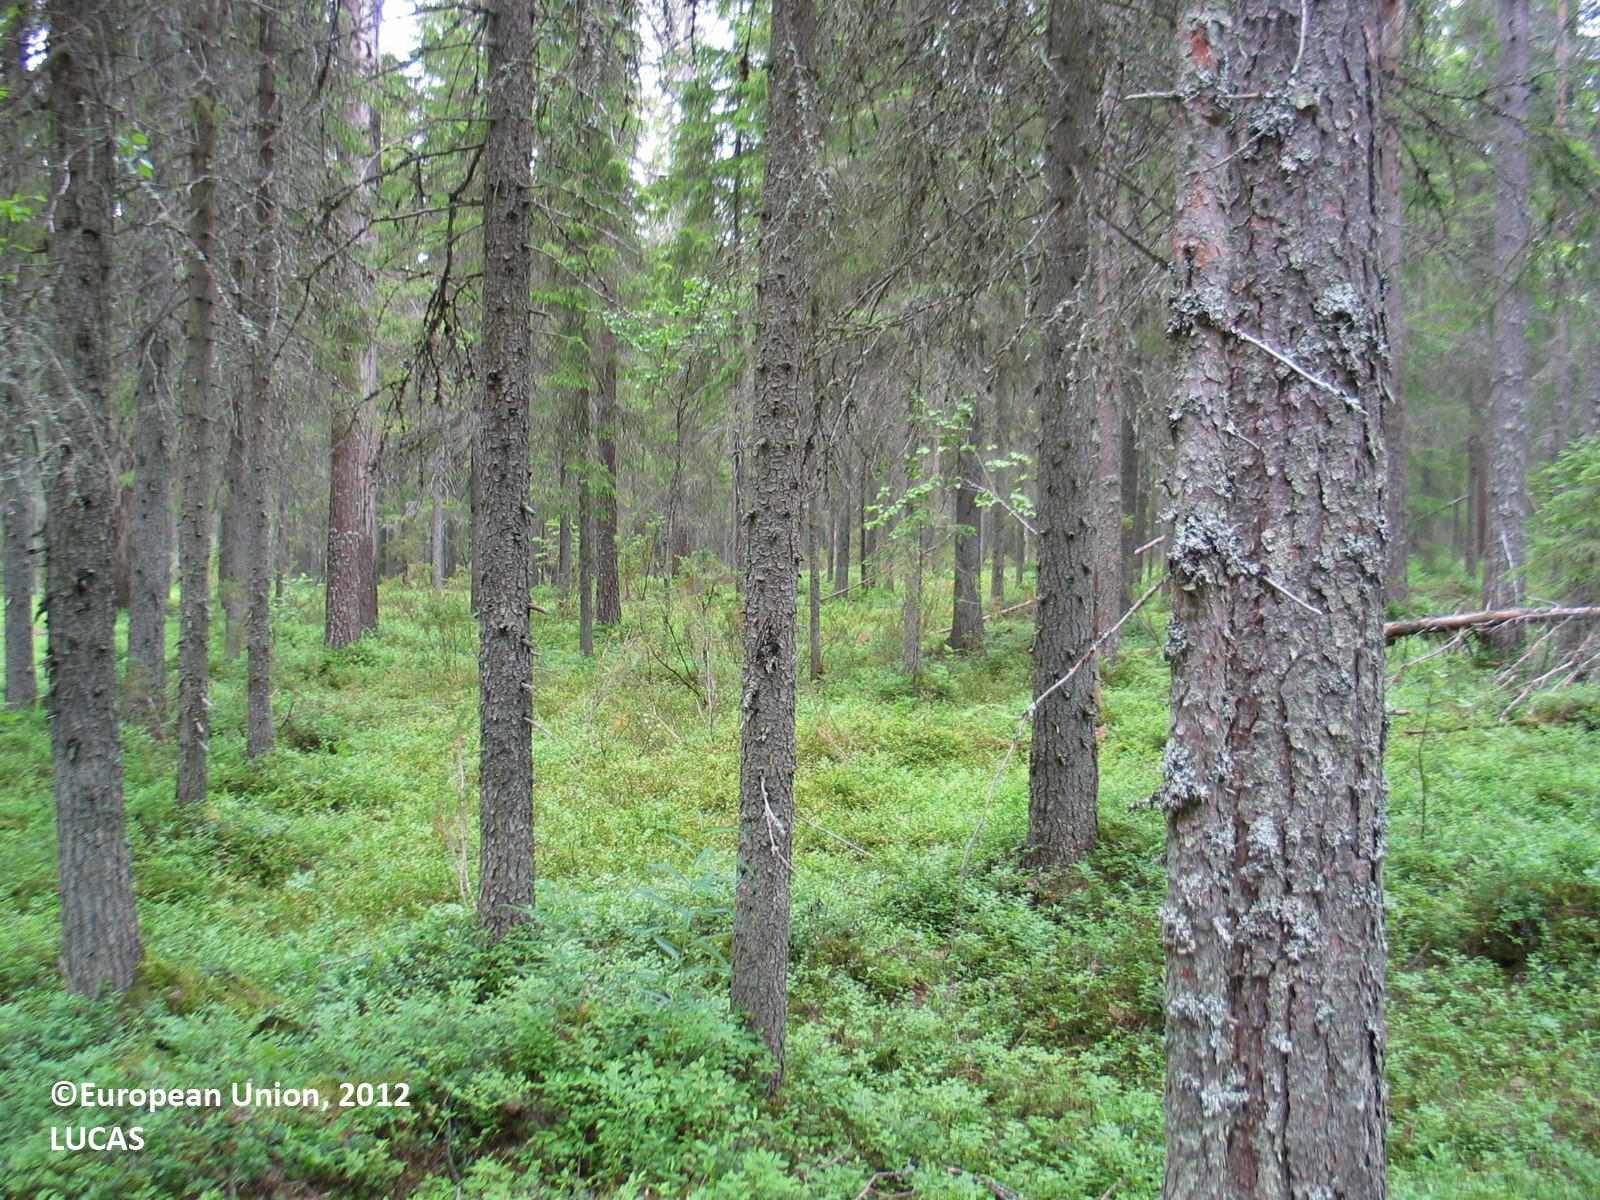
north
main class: Woodland
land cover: Spruce dominated coniferous woodland
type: boreal forest
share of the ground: 50 - 75 %
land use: Forestry
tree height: > 5 m
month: July
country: FI
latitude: 65.7633
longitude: 25.2412
